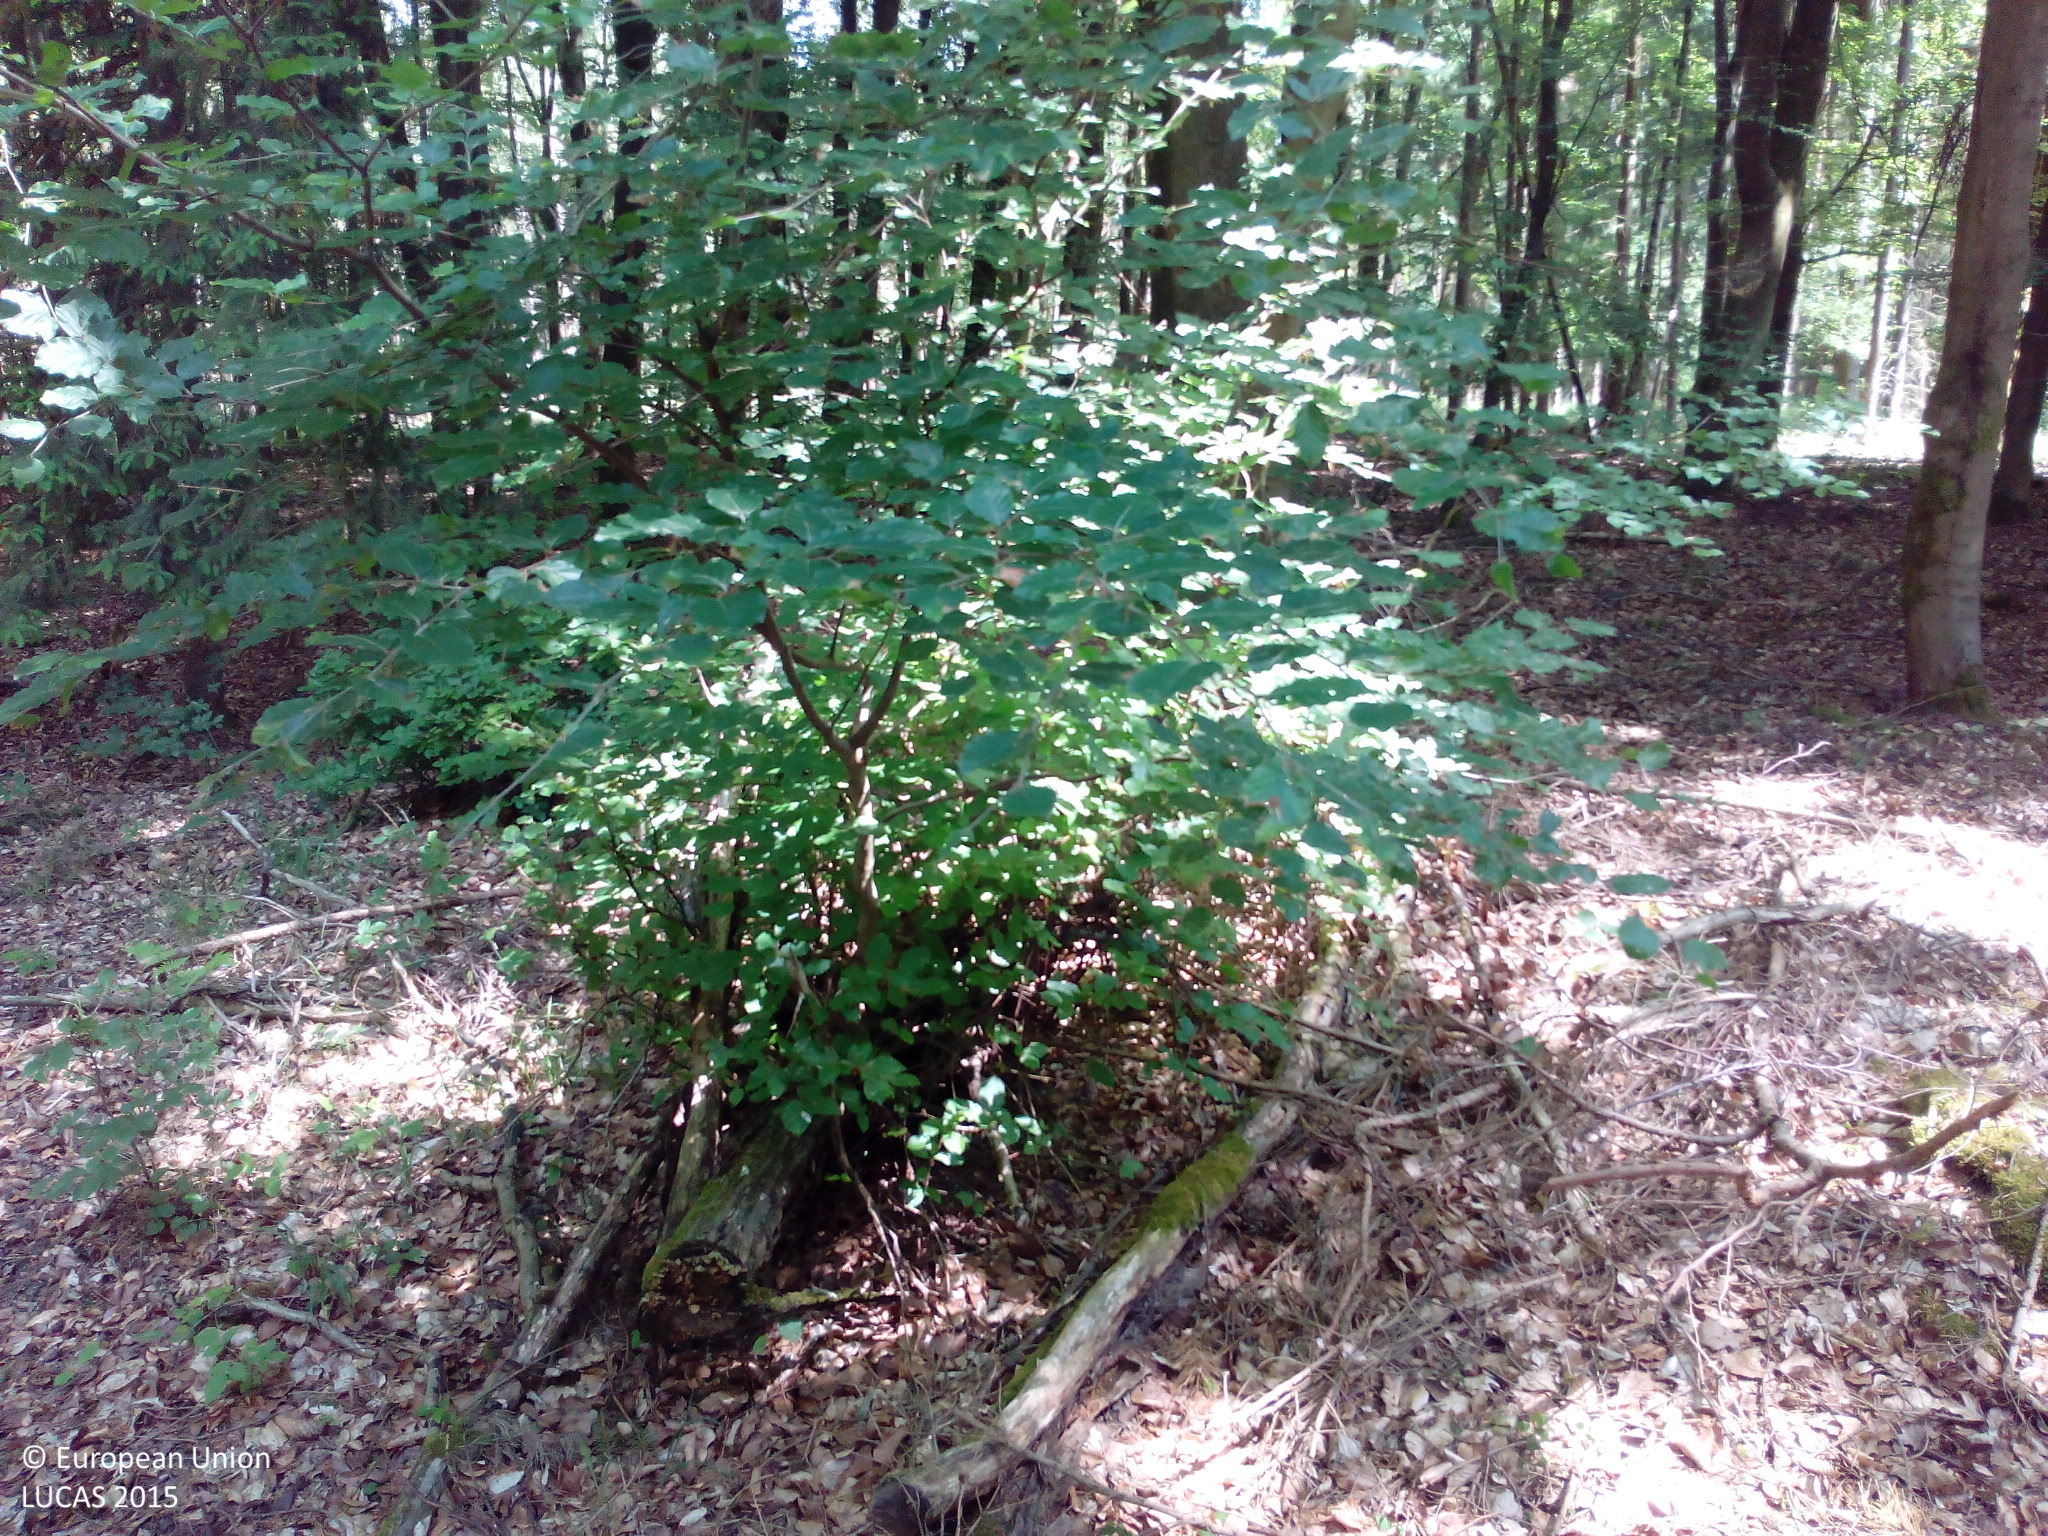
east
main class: Woodland
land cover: Other mixed woodland
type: mesophytic deciduous forest
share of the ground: > 75 %
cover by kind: broadleaved forest trees 60 %, coniferous forest trees 25 %, unconsolidated bare surface 10 %, lichens and mosses 5 %
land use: Forestry
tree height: > 5 m
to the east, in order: Other mixed woodland; Spruce dominated coniferous woodland; Spontaneously vegetated surfaces; Other bare soil; Other coniferous woodland; Spruce dominated coniferous woodland; Grassland with sparse tree/shrub cover; Other coniferous woodland
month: June
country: DE
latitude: 50.3736
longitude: 8.6084
